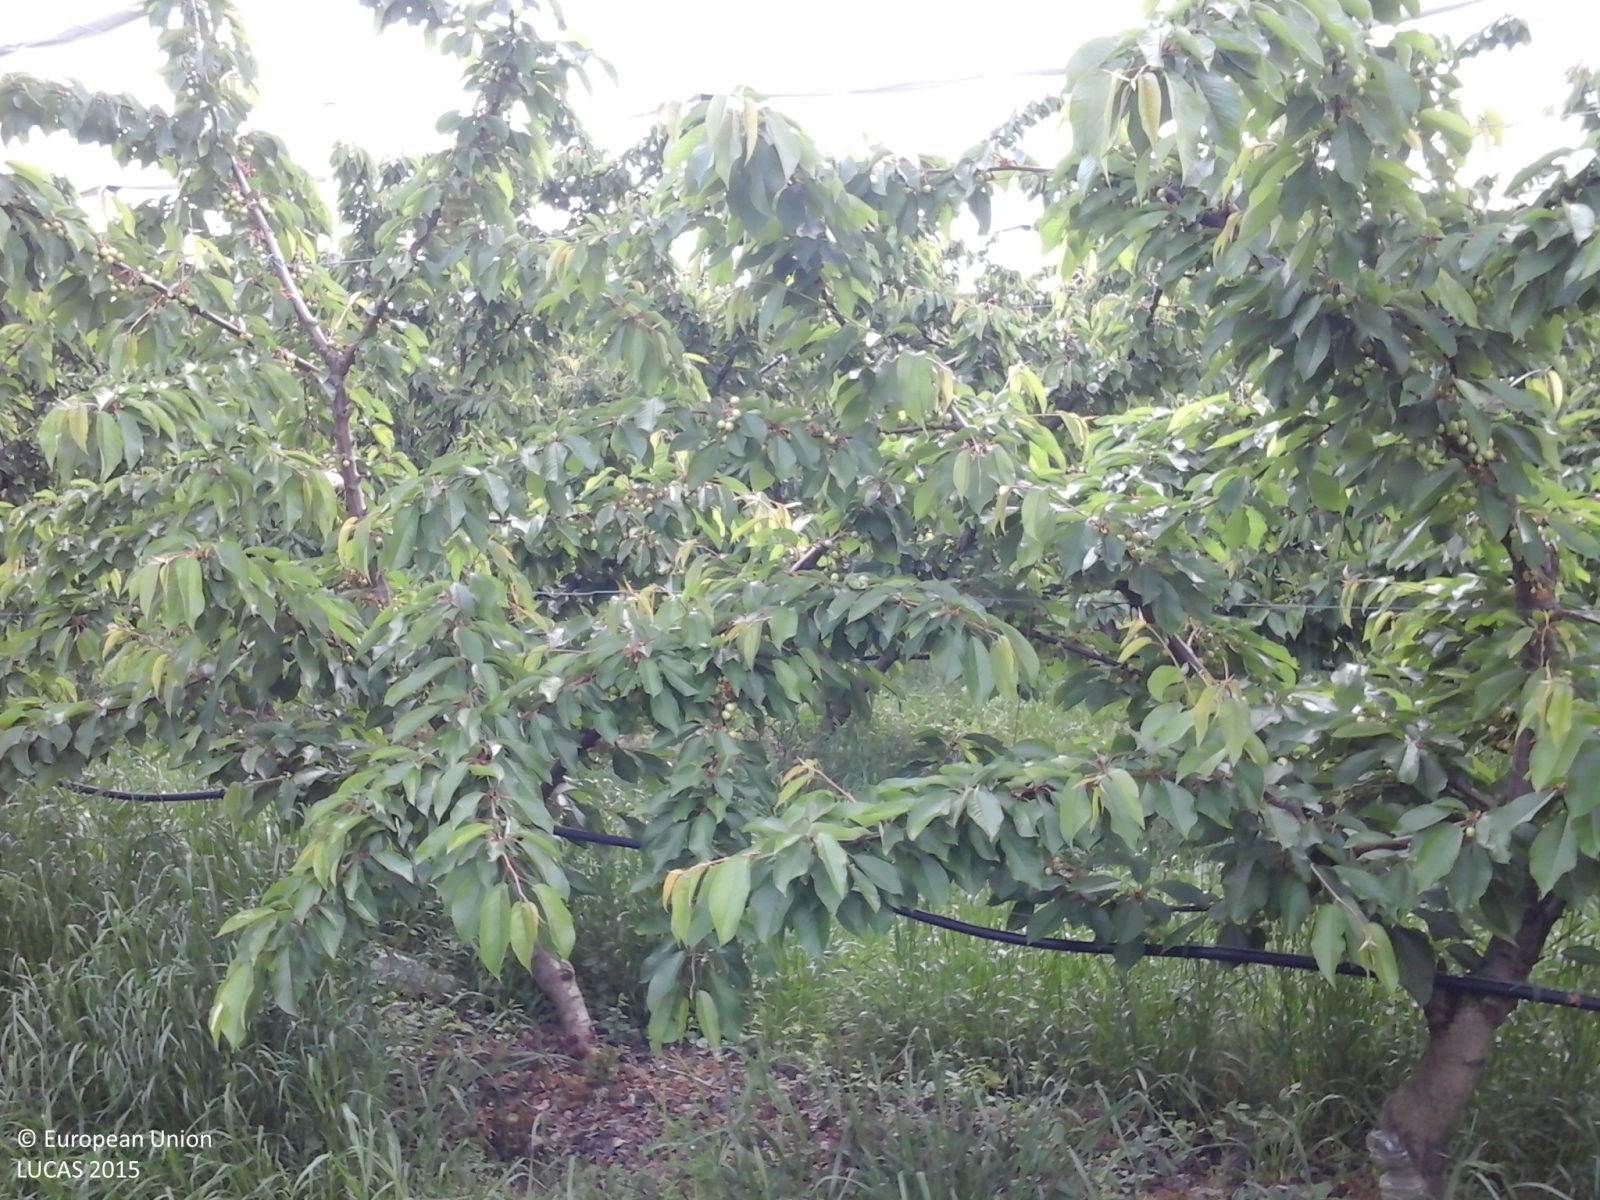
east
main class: Cropland
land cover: Cherry fruit
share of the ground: 50 - 75 %
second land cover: Grassland without tree/shrub cover
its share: > 75 %
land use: Agriculture (excluding fallow land and kitchen gardens)
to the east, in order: Cherry fruit; Grassland without tree/shrub cover; Other fruit trees and berries; Grassland without tree/shrub cover; Shrubland with sparse tree cover; Artificial constructions in urban areas
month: May
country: IT
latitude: 44.4896
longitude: 11.0414
